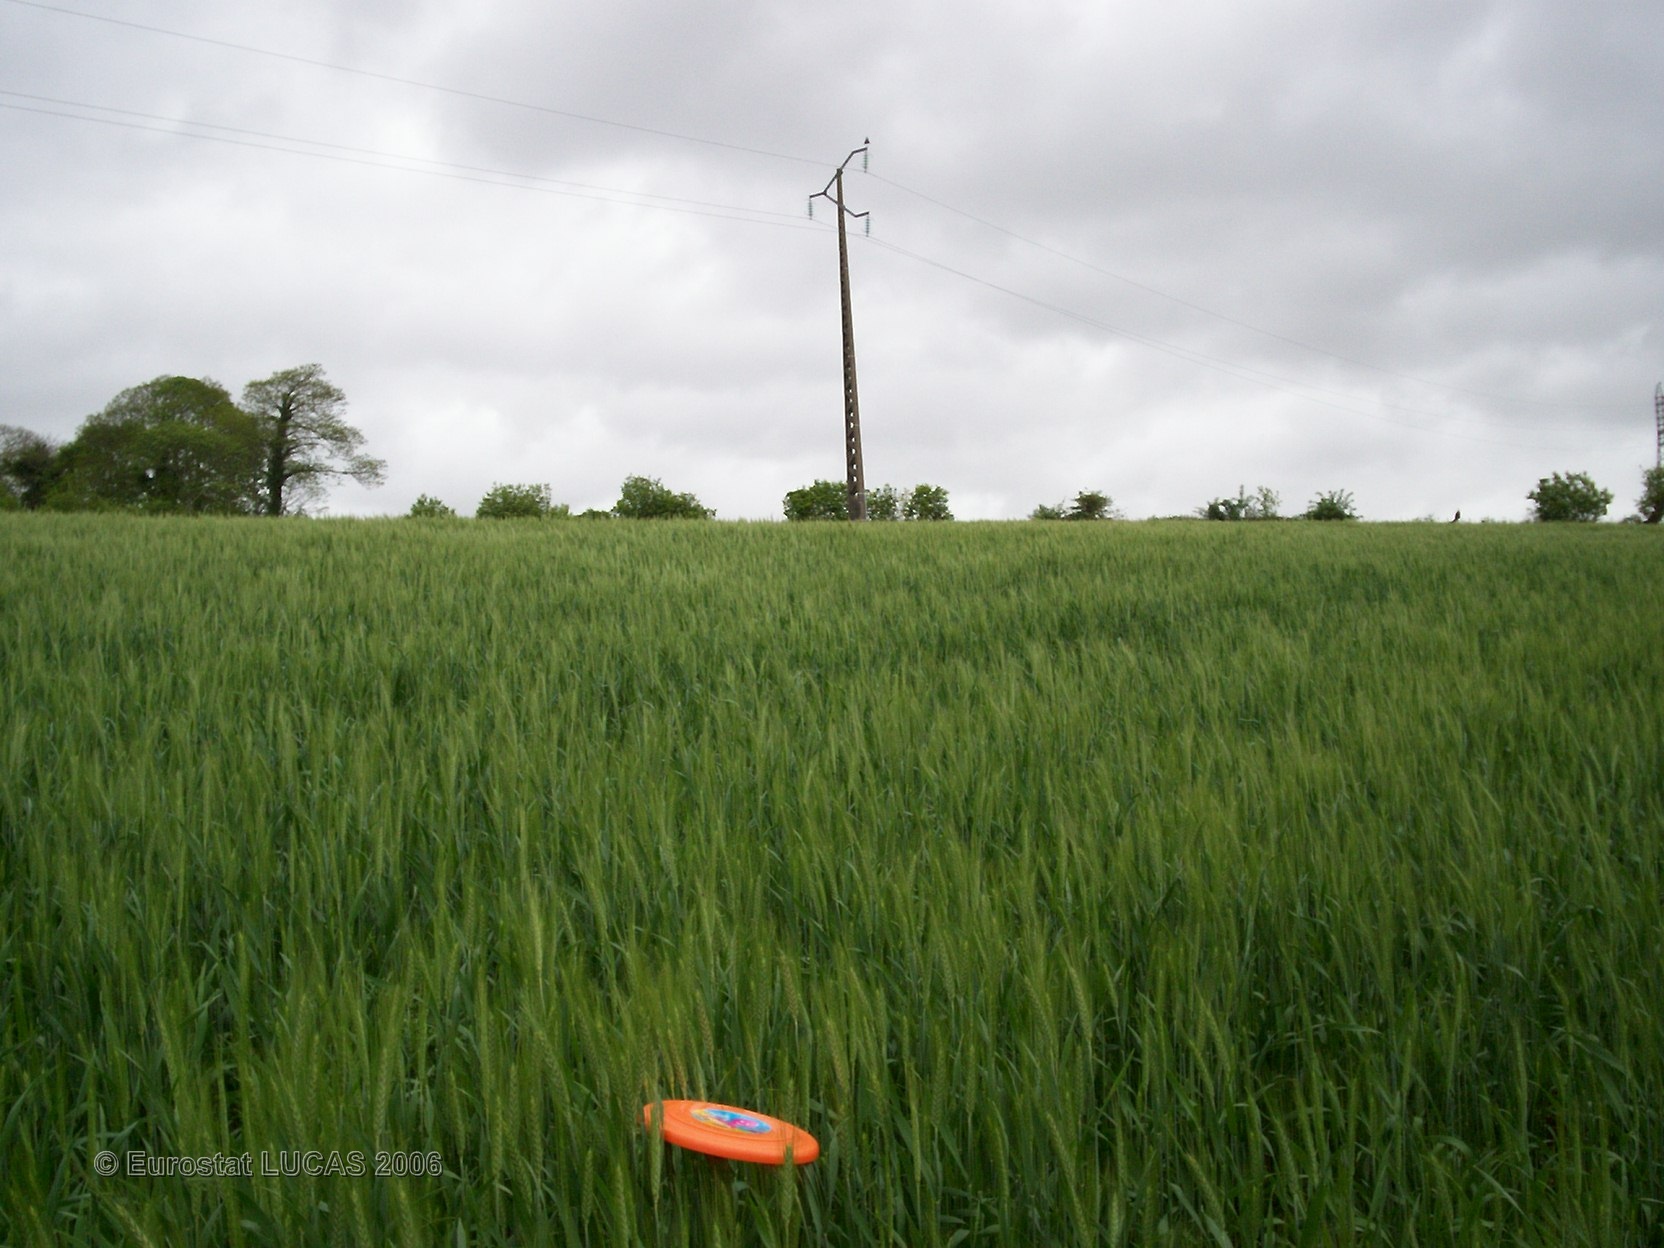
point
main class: Cropland
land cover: Common wheat
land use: Agriculture (excluding fallow land and kitchen gardens)
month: May
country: FR
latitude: 47.9242
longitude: -3.8814
